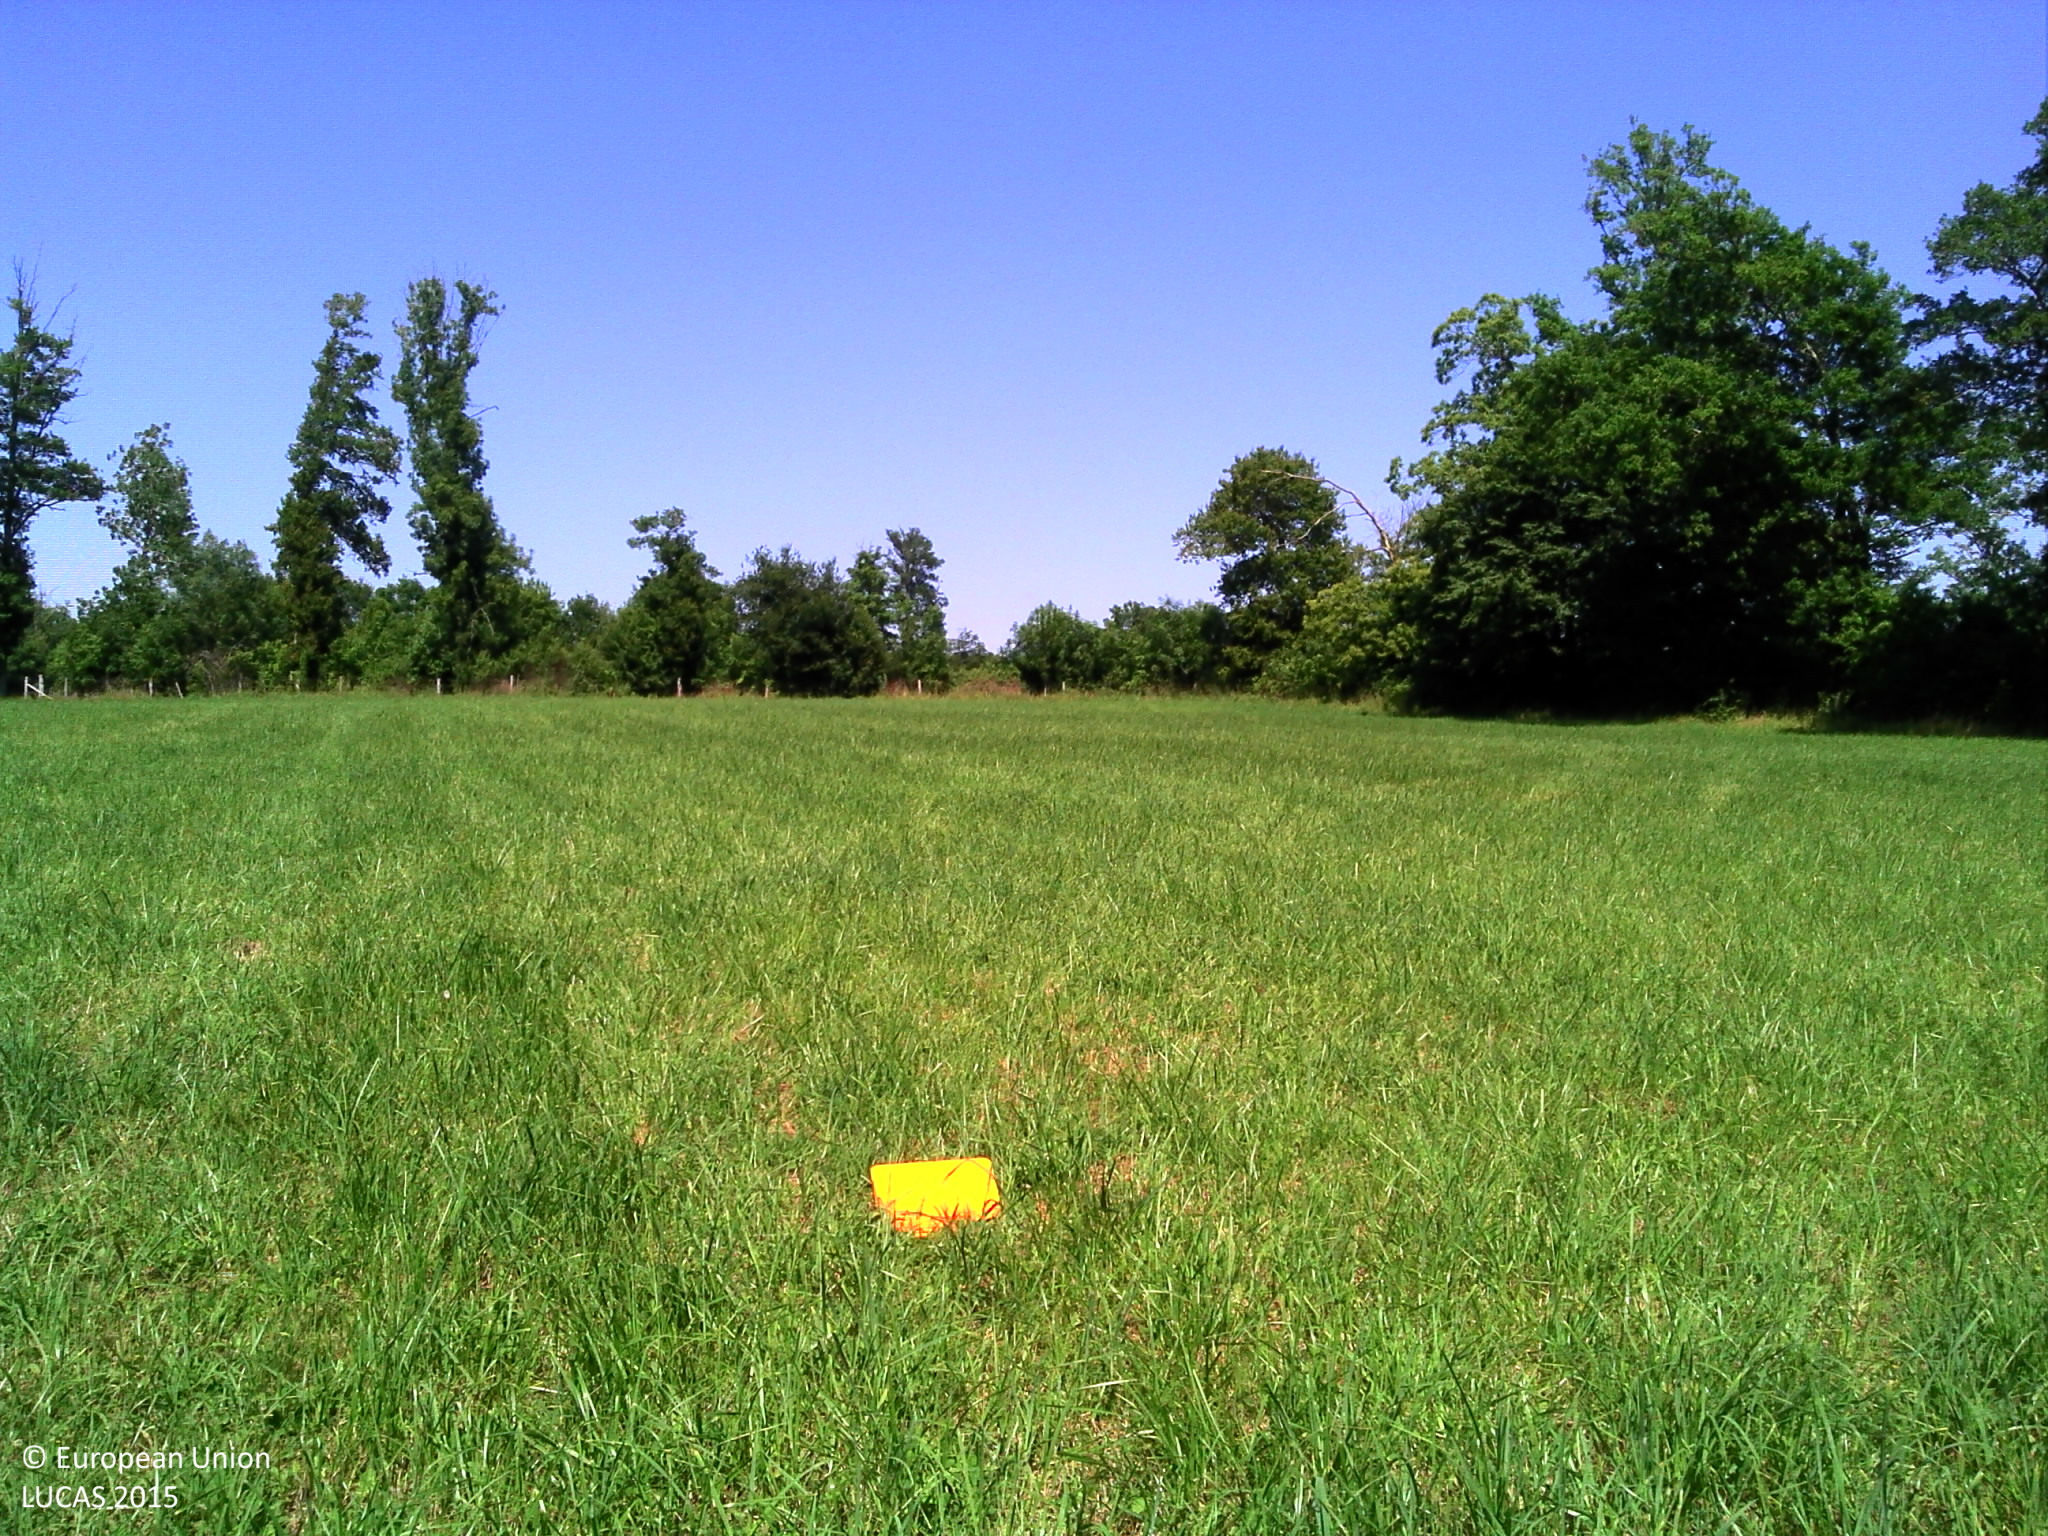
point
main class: Cropland
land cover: Temporary grasslands
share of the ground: > 75 %
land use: Agriculture (excluding fallow land and kitchen gardens)
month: June
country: FR
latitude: 45.9171
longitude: 0.5866
